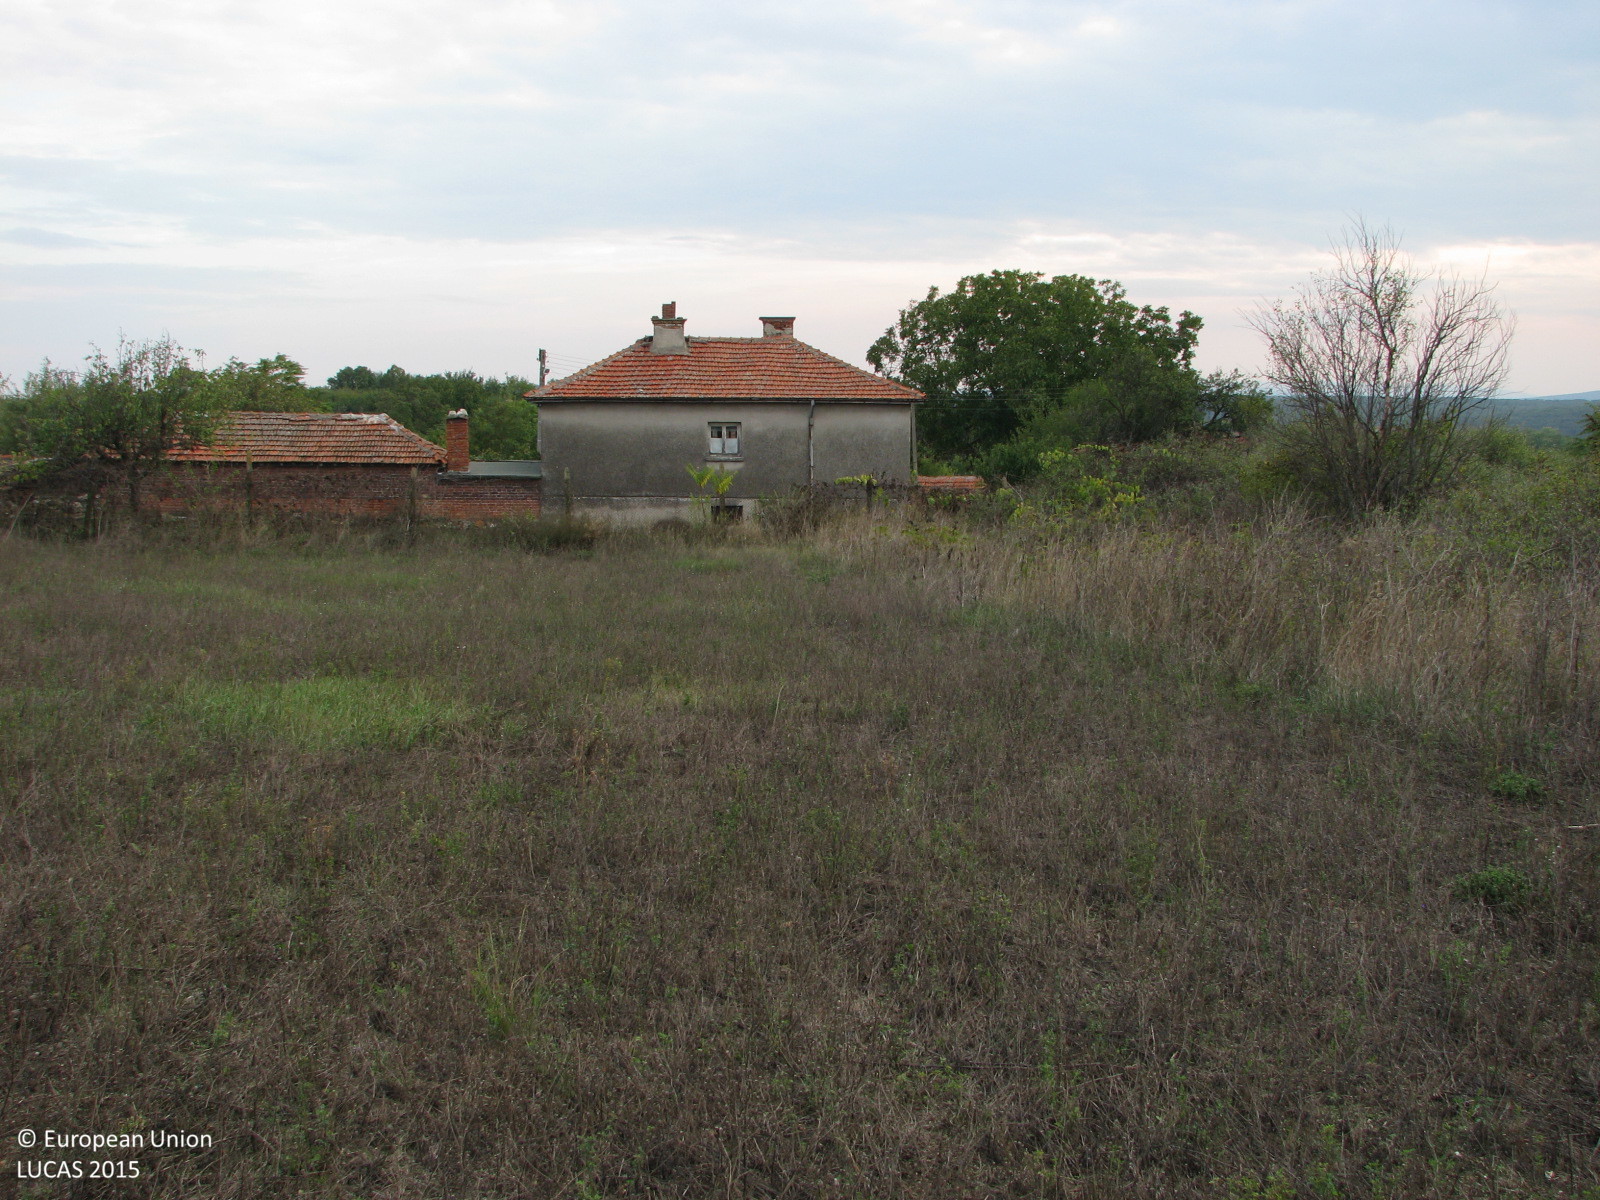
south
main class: Cropland
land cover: Lucerne
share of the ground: 25 - 50 %
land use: Agriculture (excluding fallow land and kitchen gardens)
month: October
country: BG
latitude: 42.2797
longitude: 26.5207
